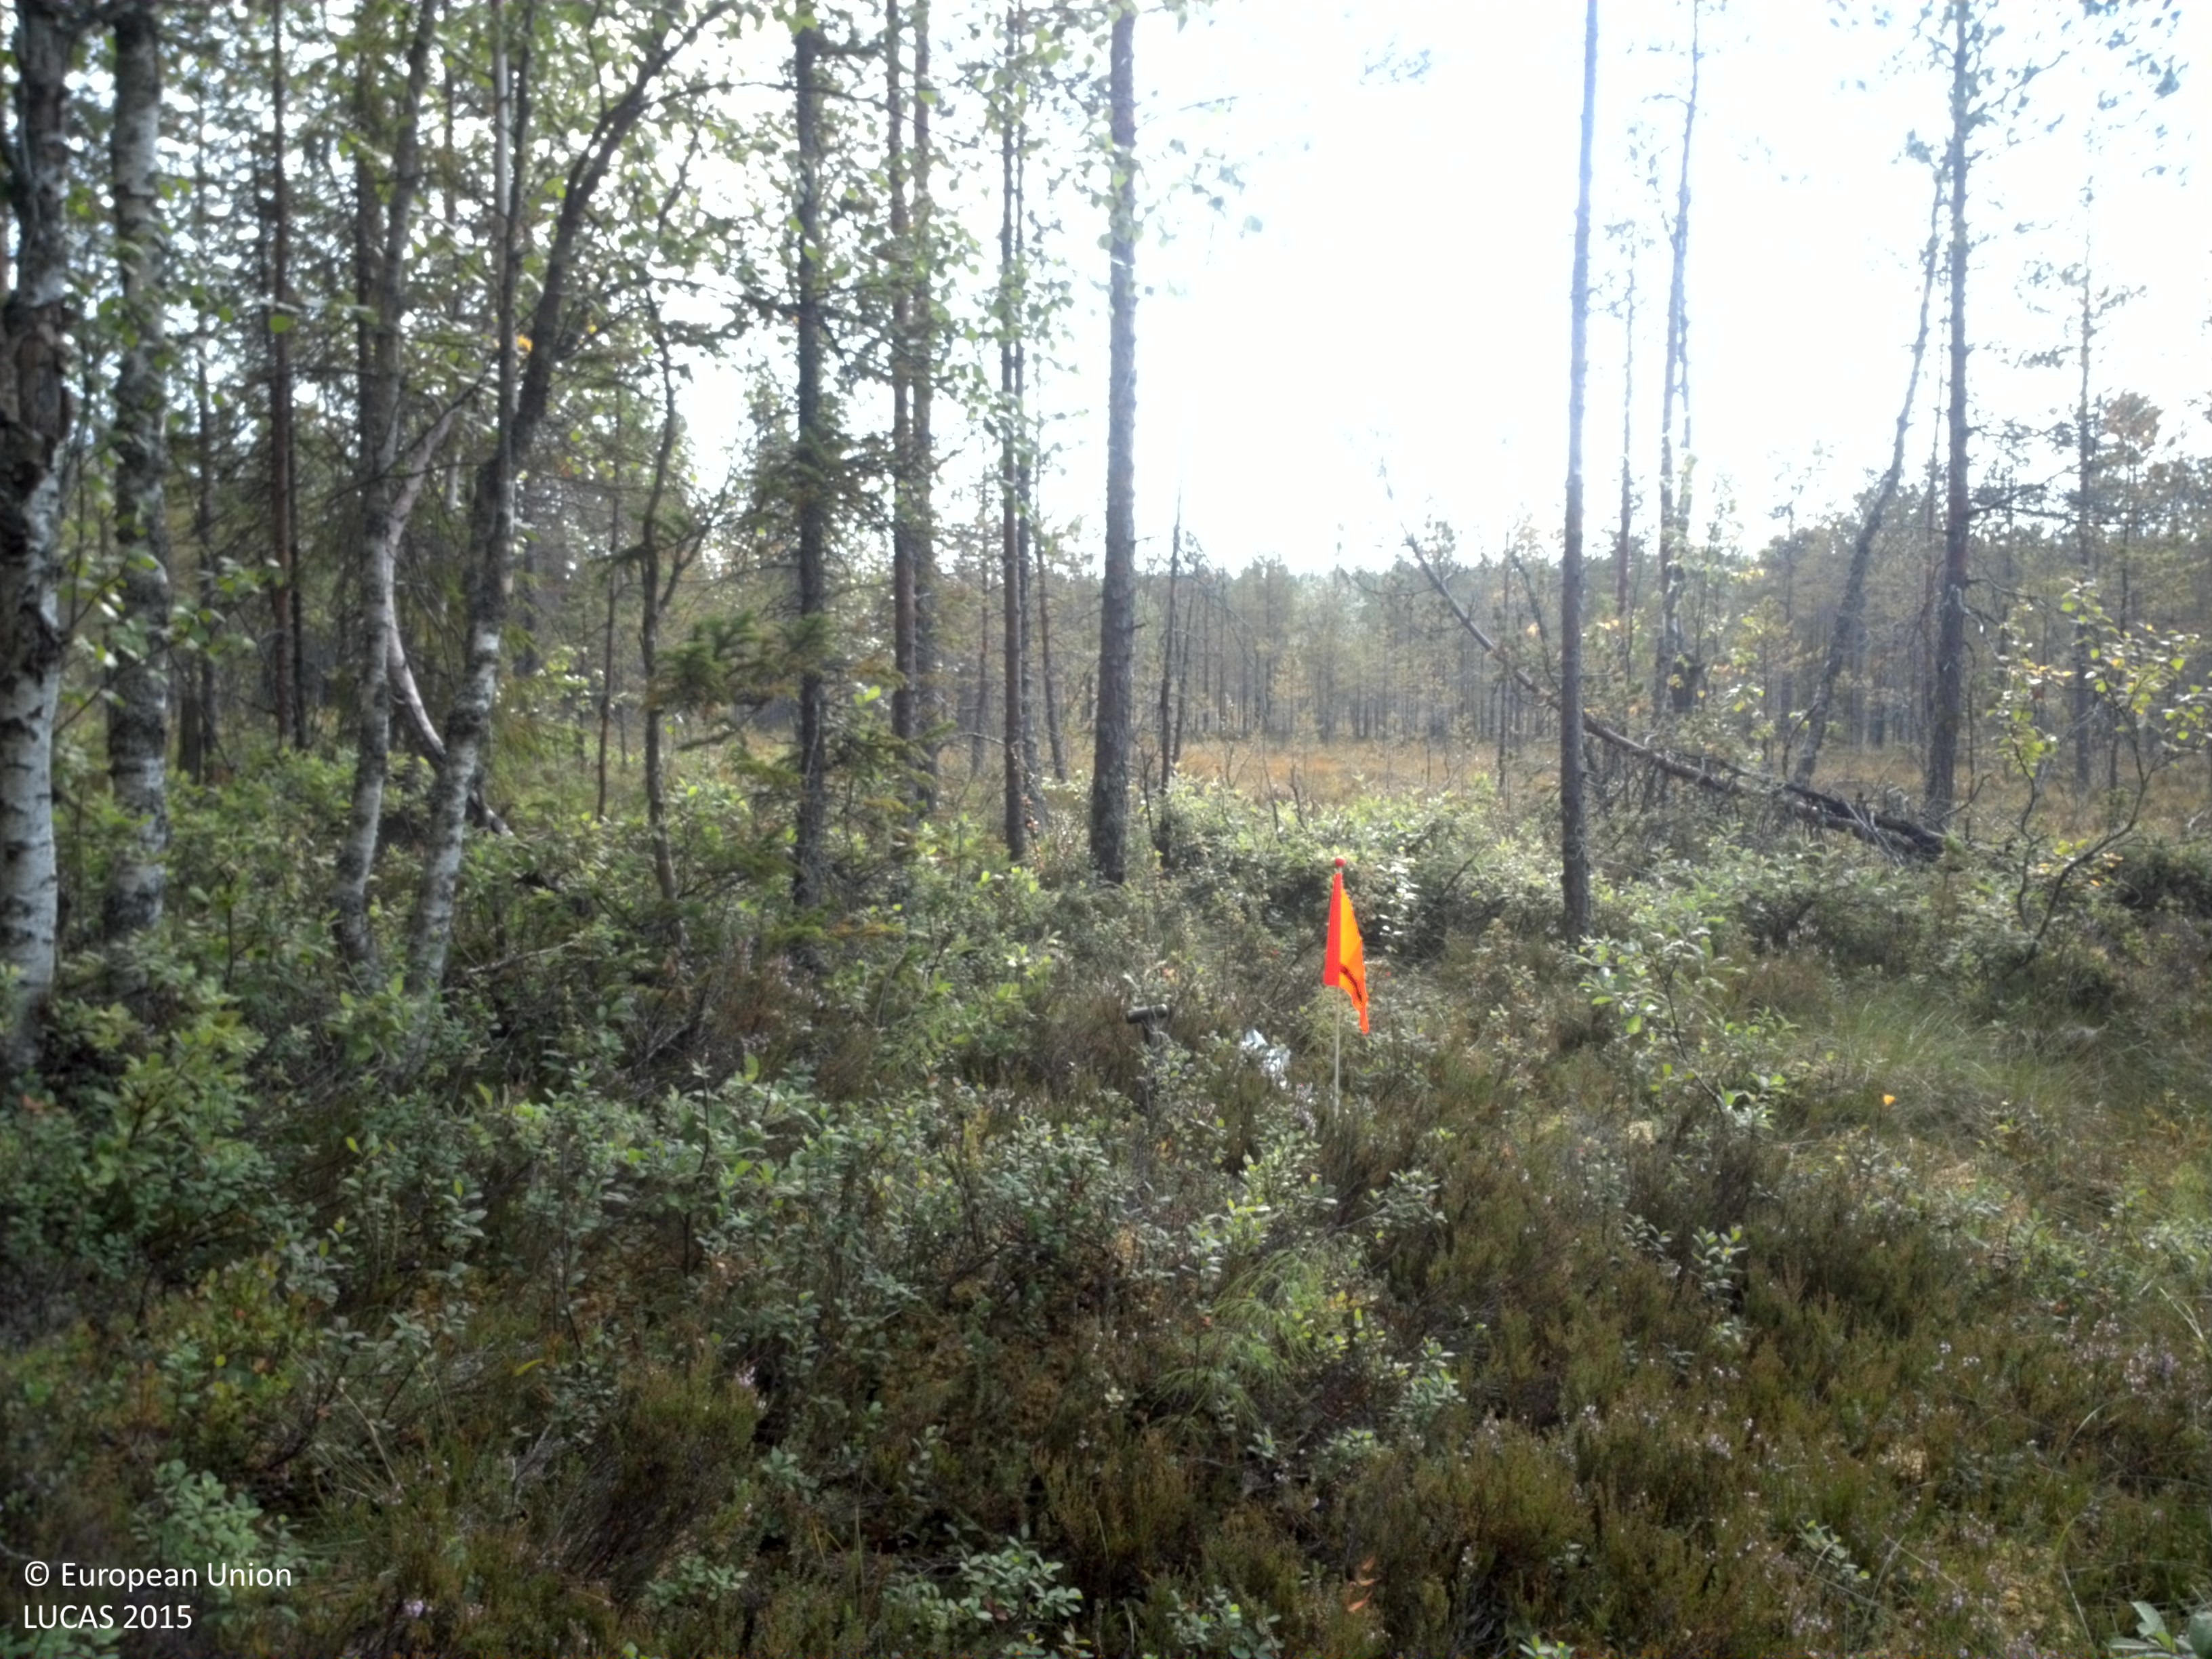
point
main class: Woodland
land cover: Pine dominated mixed woodland
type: boreal forest
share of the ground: 25 - 50 %
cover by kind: coniferous forest trees 35 %, lichens and mosses 25 %, shrubs 20 %, broadleaved forest trees 15 %, herbaceous plants 5 %
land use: Forestry
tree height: > 5 m
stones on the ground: < 10 %
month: August
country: SE
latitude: 61.8628
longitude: 14.9443
